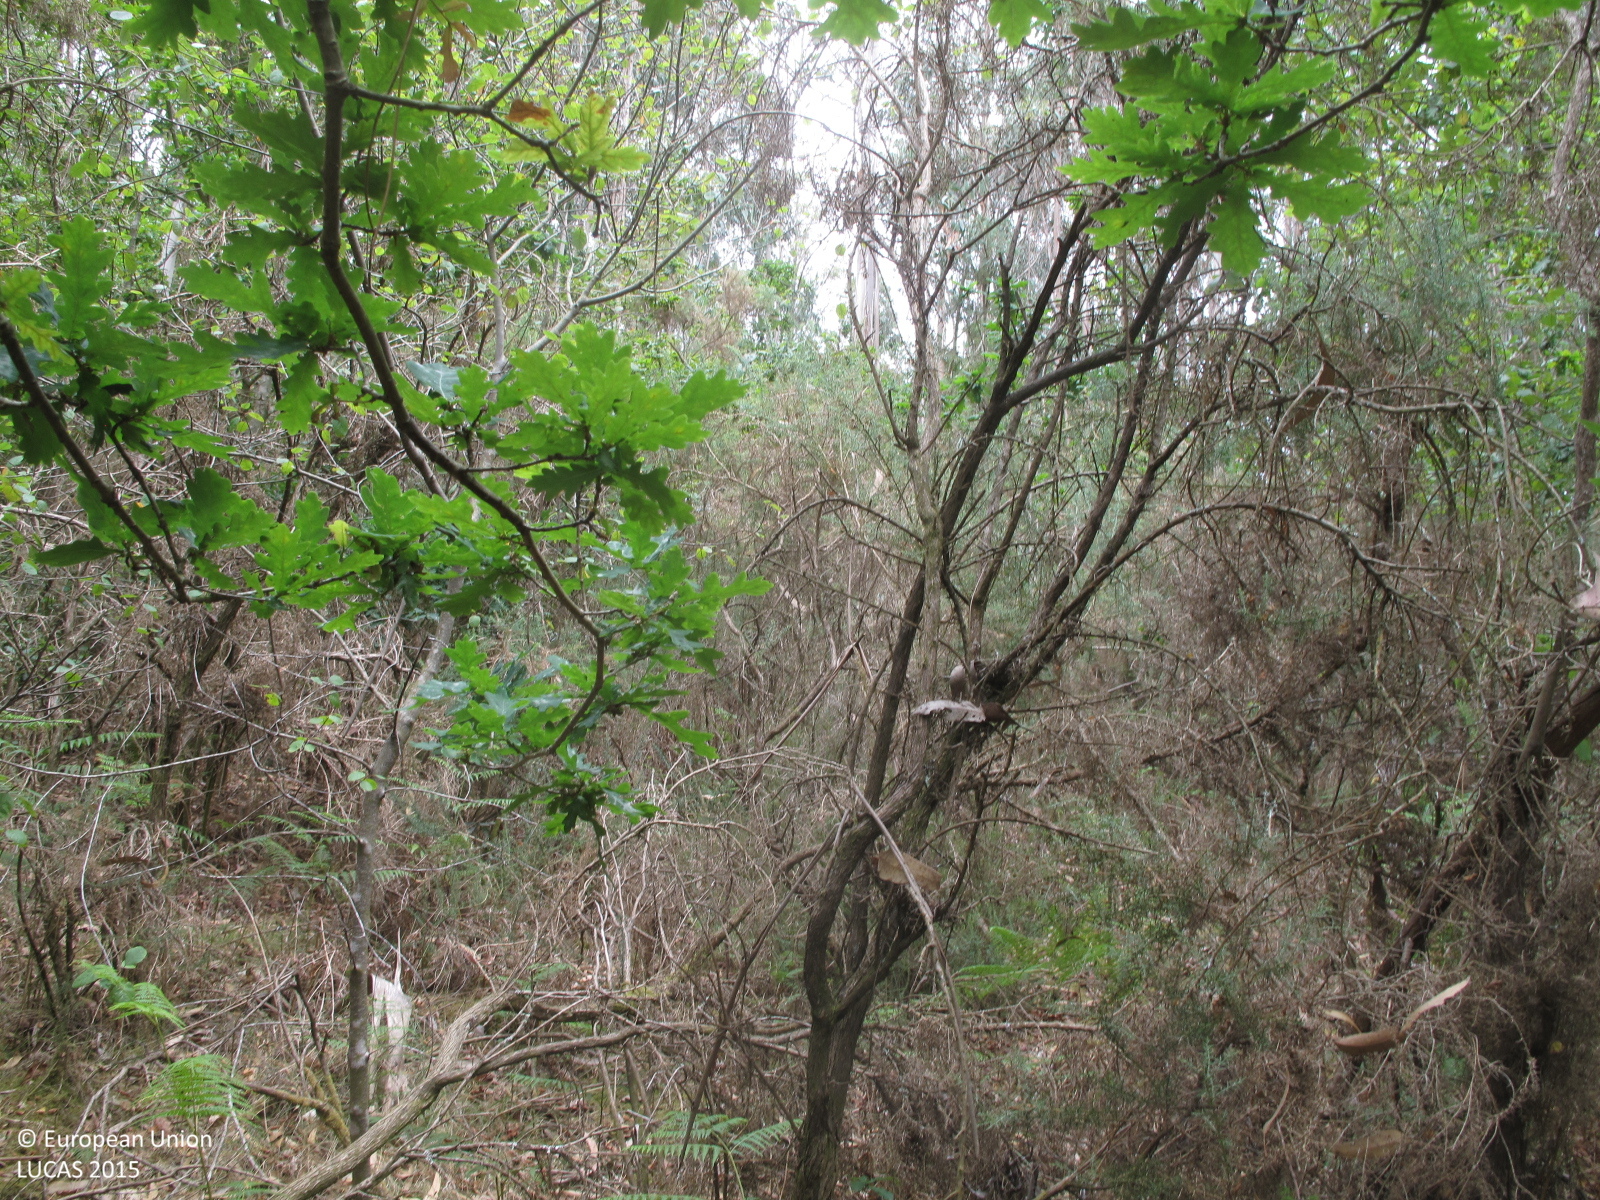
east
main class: Woodland
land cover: Broadleaved woodland
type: exotic forest
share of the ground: 50 - 75 %
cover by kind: broadleaved forest trees 70 %, shrubs 30 %
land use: Forestry
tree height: > 5 m
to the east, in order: Broadleaved woodland; Tracks; Broadleaved woodland
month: July
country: ES
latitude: 43.4740
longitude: -8.1363
